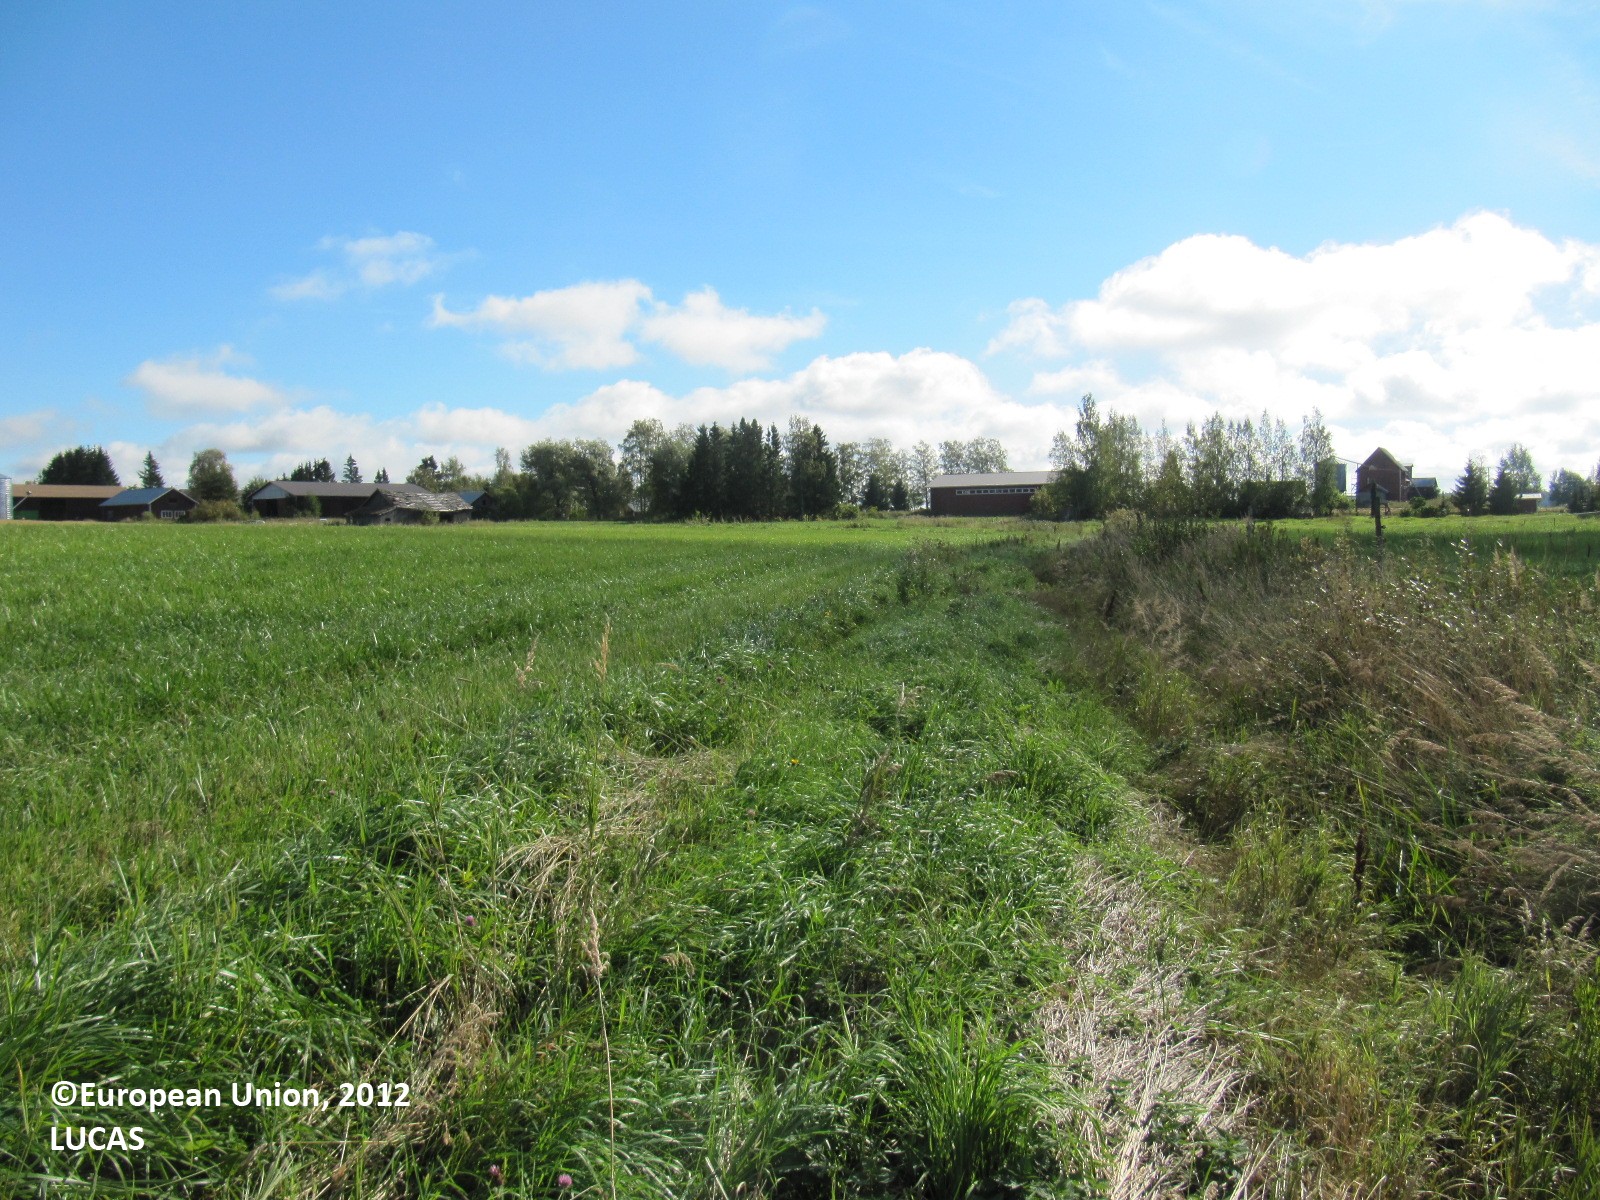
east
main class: Grassland
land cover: Grassland without tree/shrub cover
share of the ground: > 75 %
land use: Fallow land
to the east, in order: Grassland without tree/shrub cover; Fences; Spontaneously vegetated surfaces; Ditches and canals; Spontaneously vegetated surfaces; Grassland without tree/shrub cover; Ditches and canals; Grassland without tree/shrub cover; Spruce dominated mixed woodland; Grassland with sparse tree/shrub cover; Other mixed woodland; Grass margins; Paved roads, cycling and walking lanes; Grassland with sparse tree/shrub cover
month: September
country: FI
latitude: 60.7857
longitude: 23.3618
